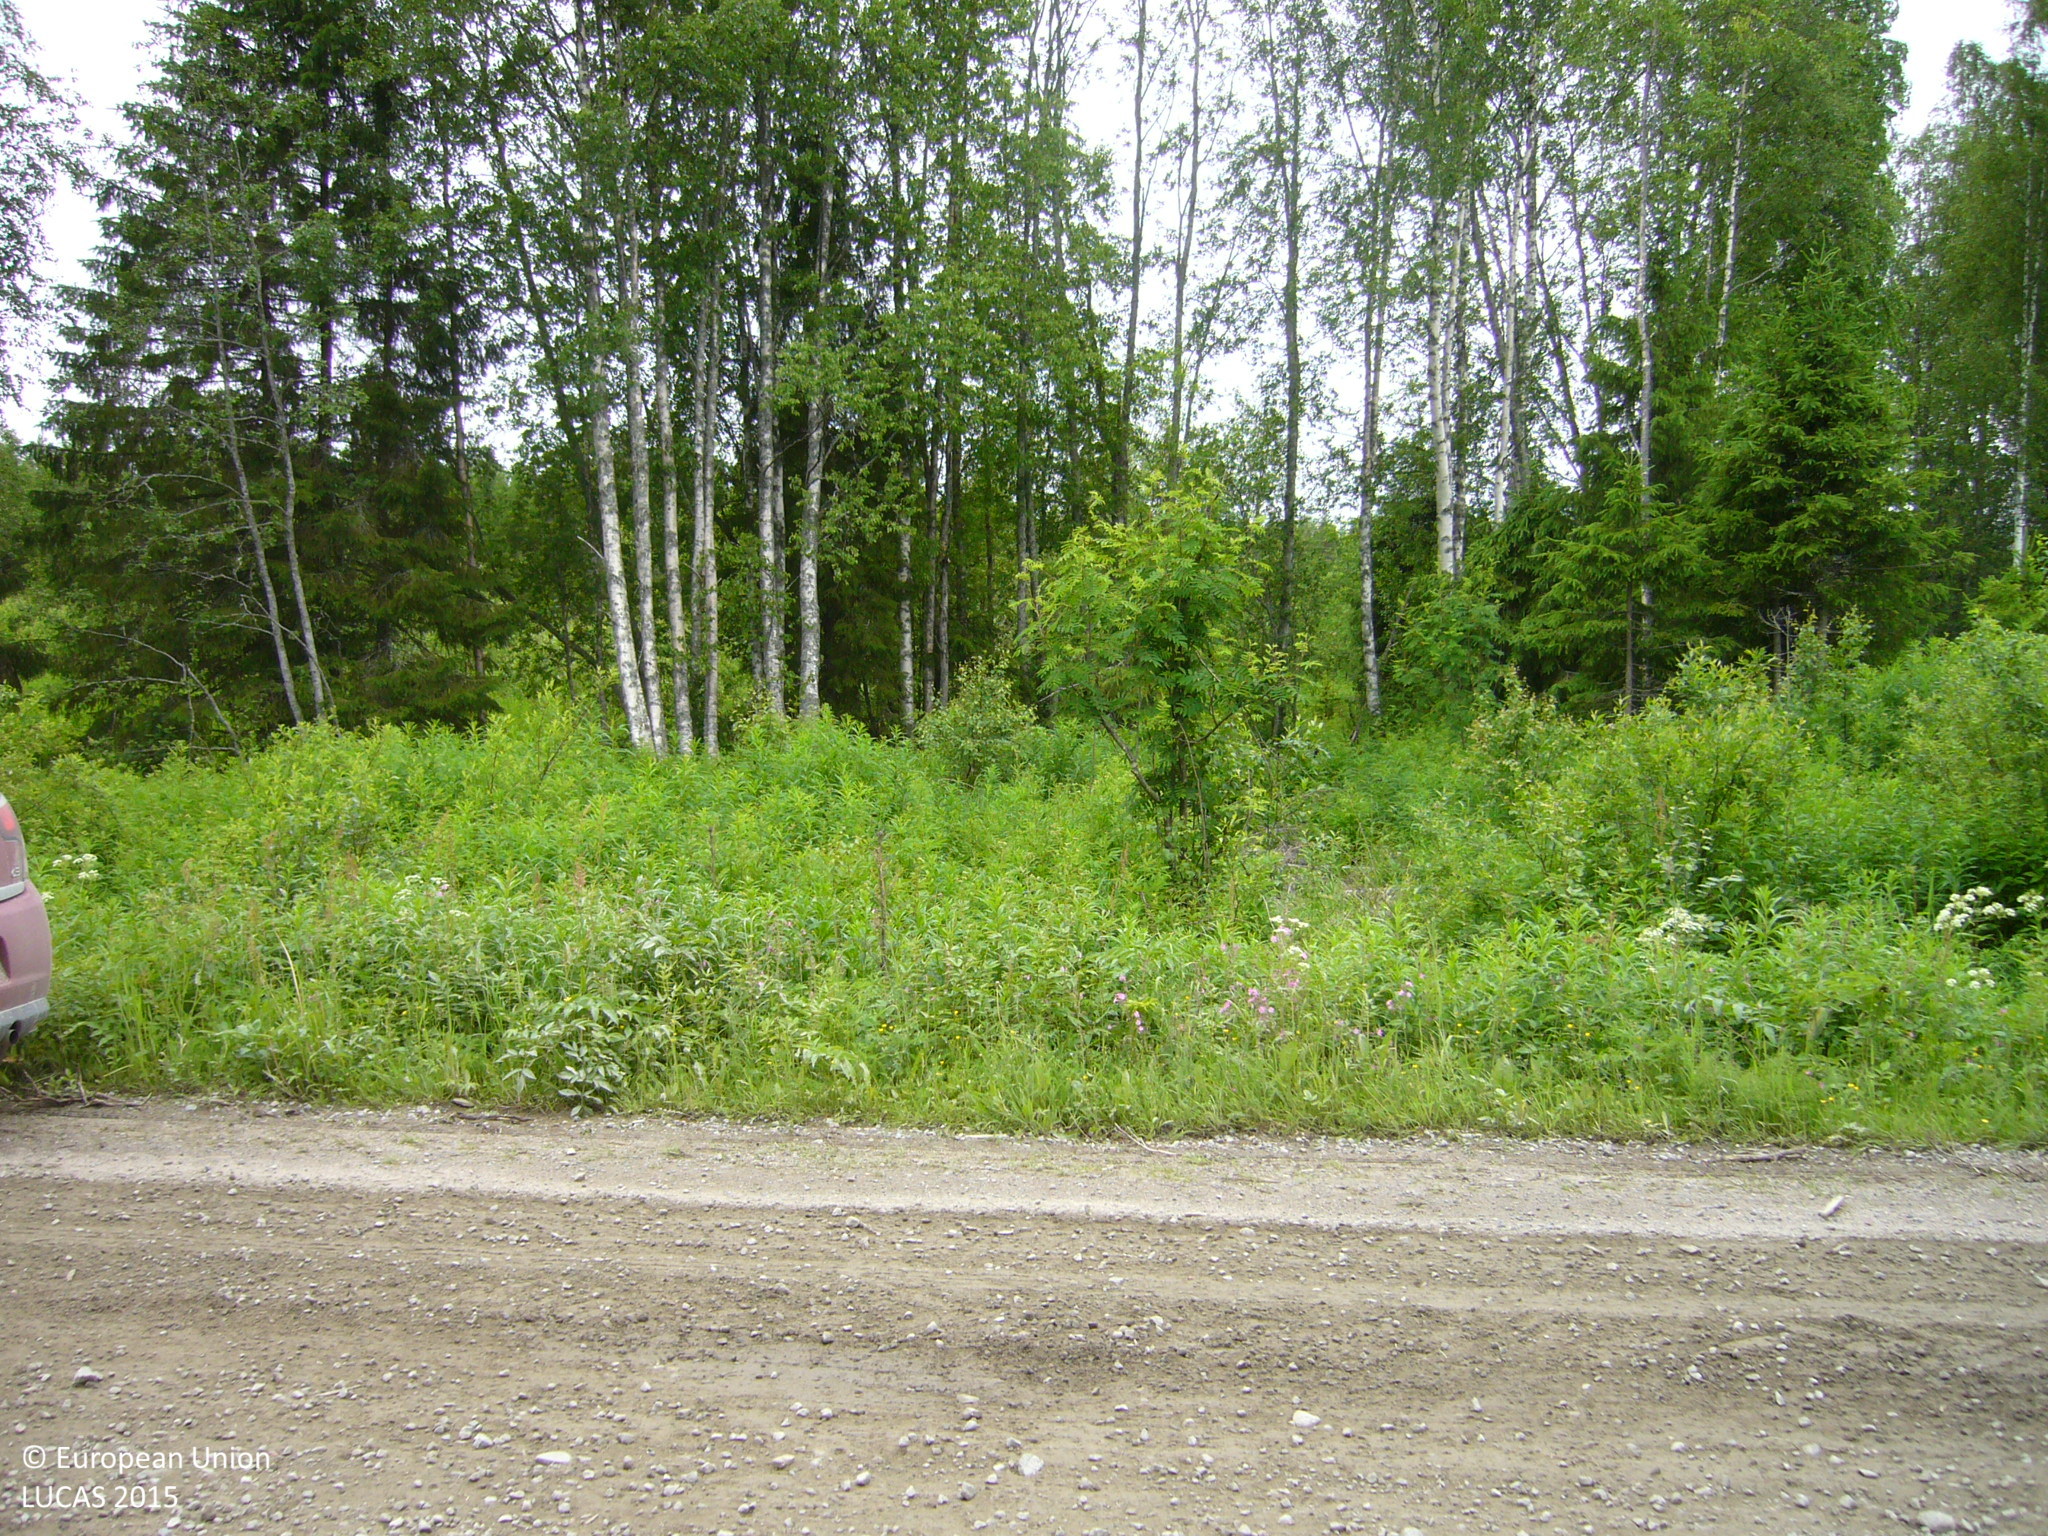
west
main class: Woodland
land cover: Other mixed woodland
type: boreal forest
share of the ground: > 75 %
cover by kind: broadleaved forest trees 50 %, coniferous forest trees 25 %, herbaceous plants 20 %, shrubs 5 %
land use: Forestry
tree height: > 5 m
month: July
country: FI
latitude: 63.4714
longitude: 26.4817
